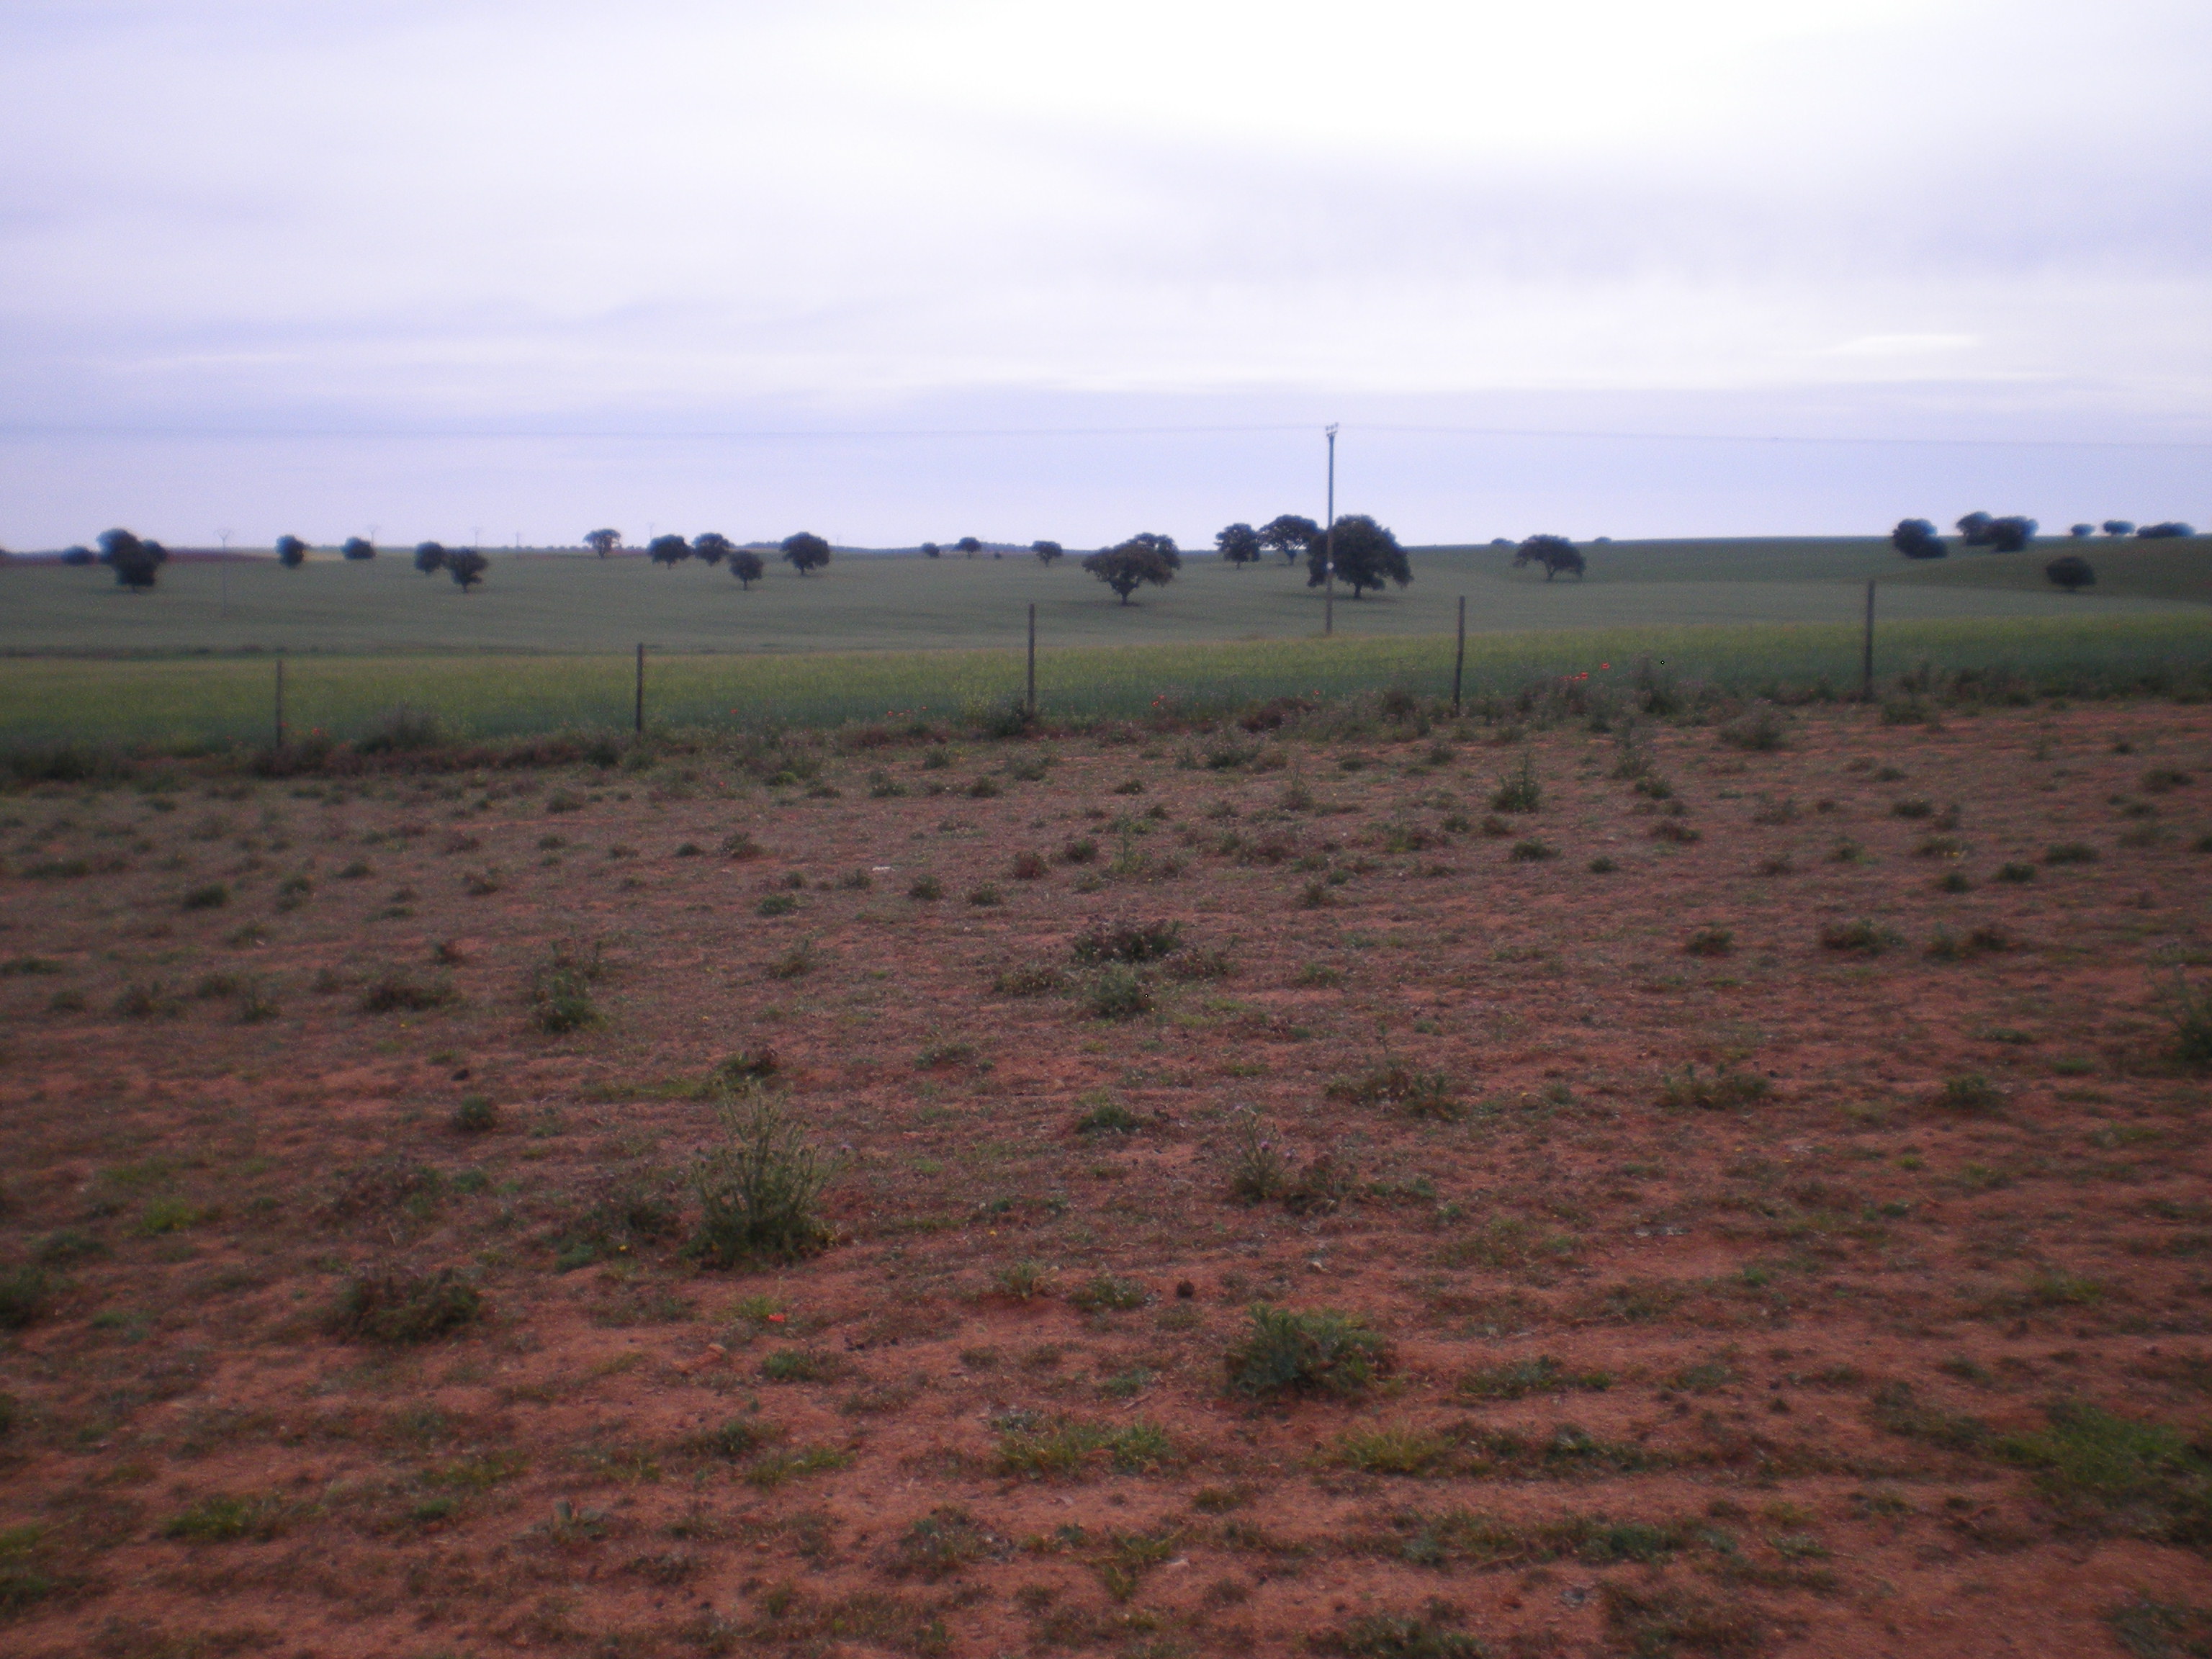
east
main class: Grassland
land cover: Spontaneously vegetated surfaces
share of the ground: 25 - 50 %
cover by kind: unconsolidated bare surface 75 %, herbaceous plants 25 %
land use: Agriculture (excluding fallow land and kitchen gardens)
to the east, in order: Spontaneously vegetated surfaces; Grass margins; Fences; Barley; Electric lines; Barley
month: May
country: ES
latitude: 38.6615
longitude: -3.1658
